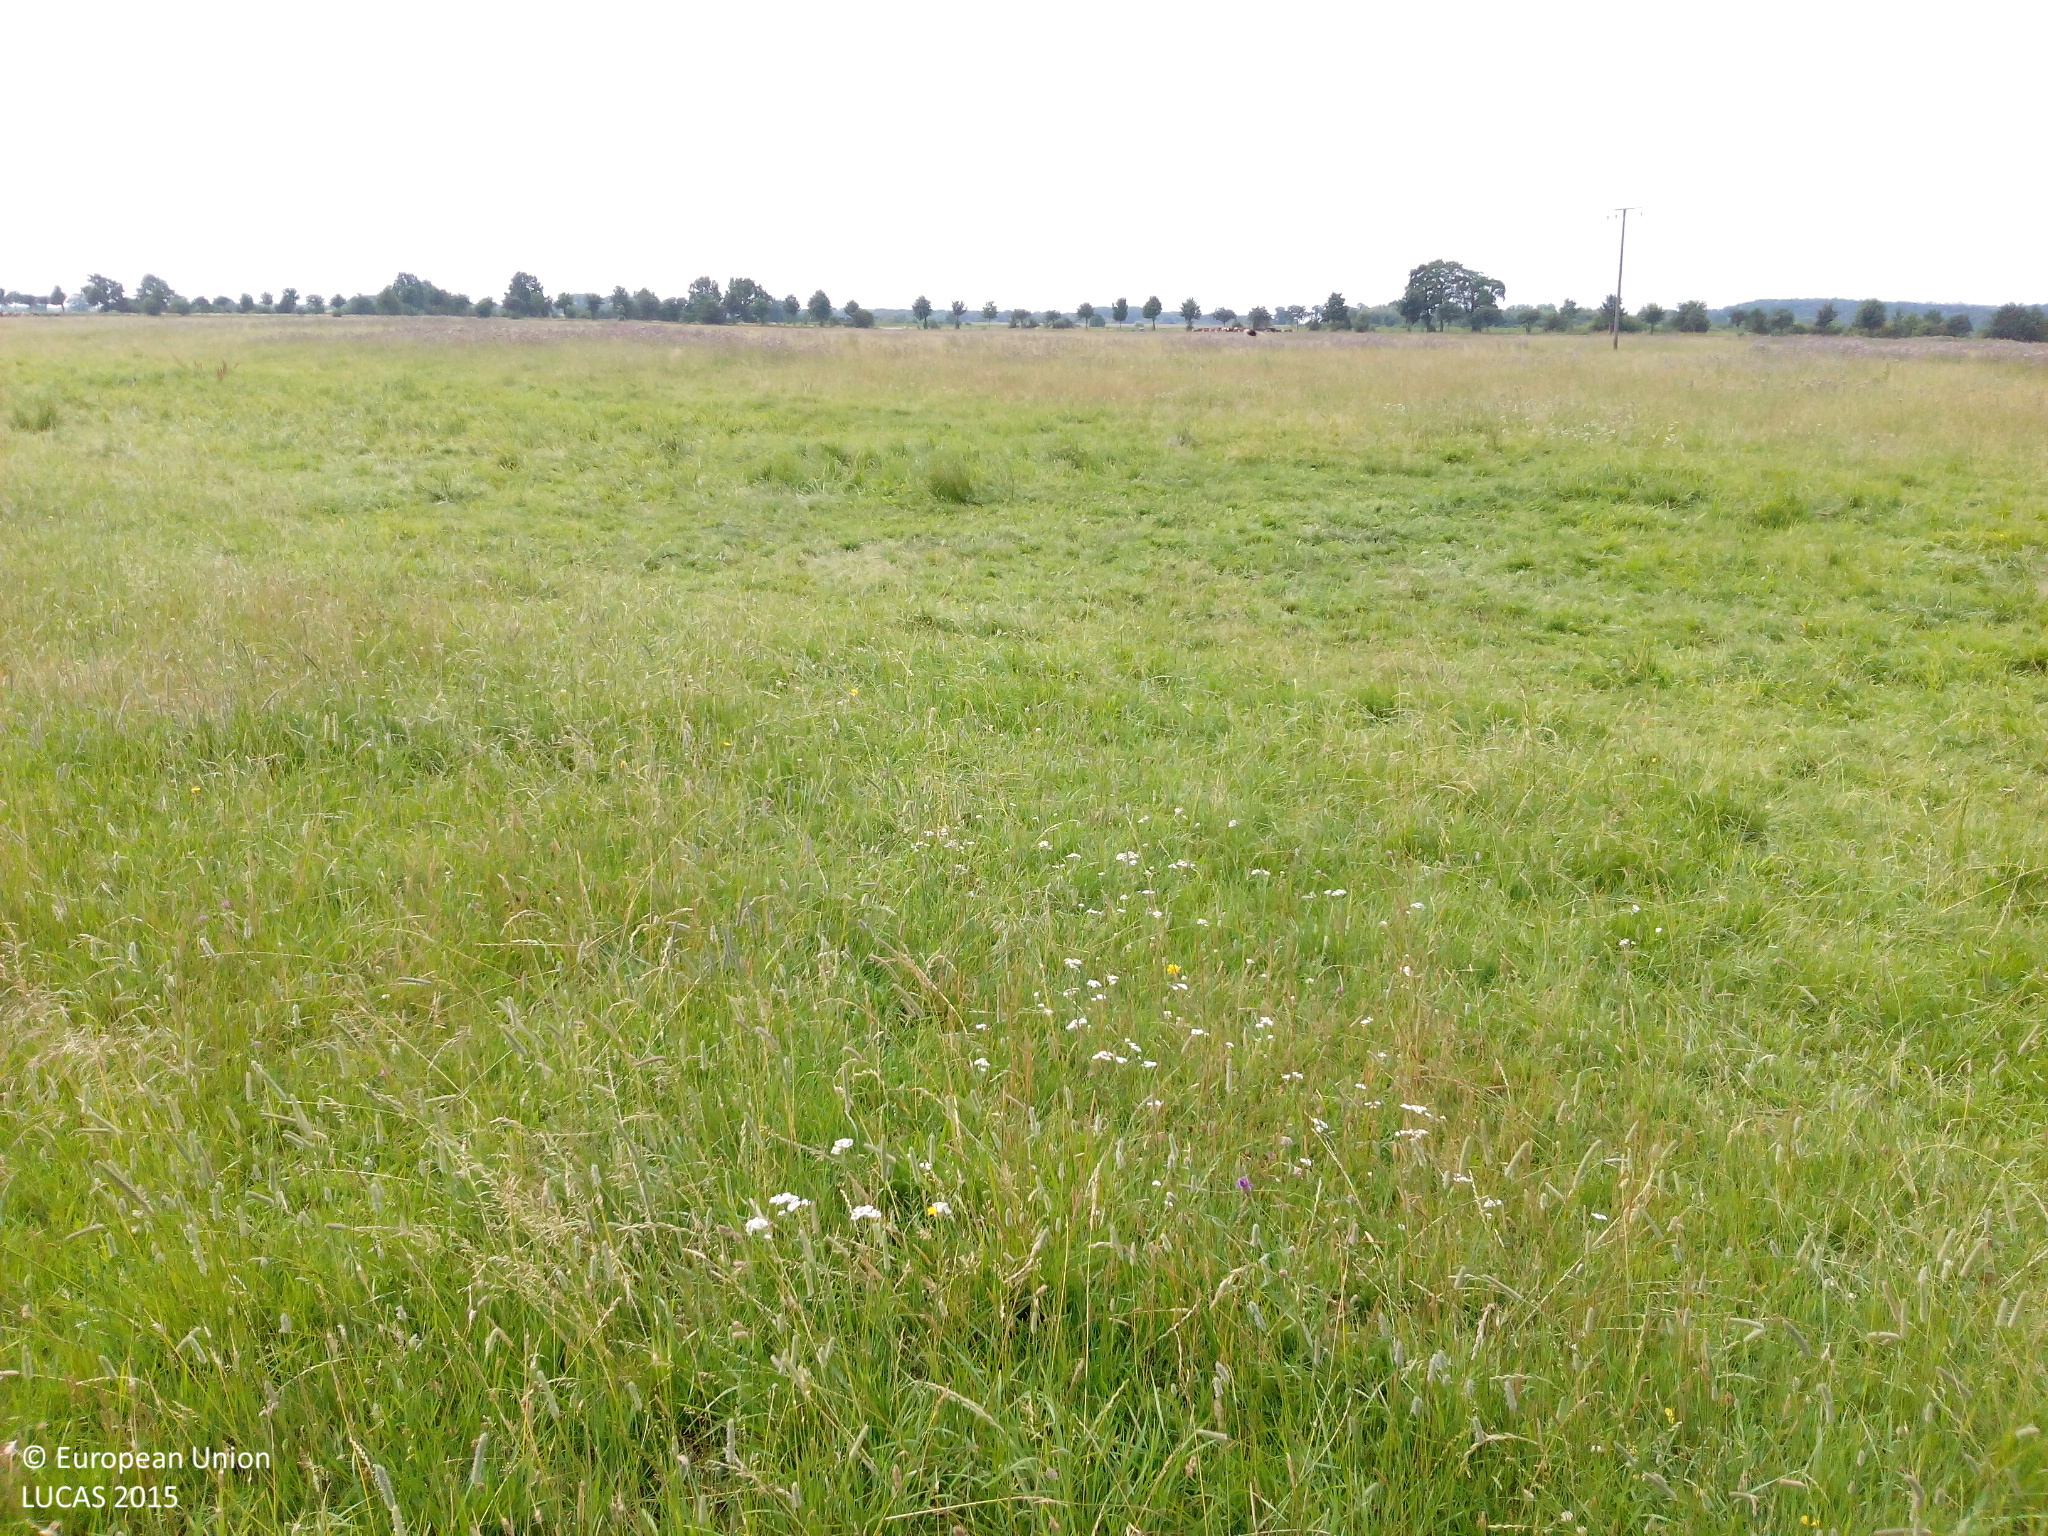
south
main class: Grassland
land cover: Grassland without tree/shrub cover
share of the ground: > 75 %
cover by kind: herbaceous plants 100 %
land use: Agriculture (excluding fallow land and kitchen gardens)
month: July
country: DE
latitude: 53.0873
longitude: 11.4776
